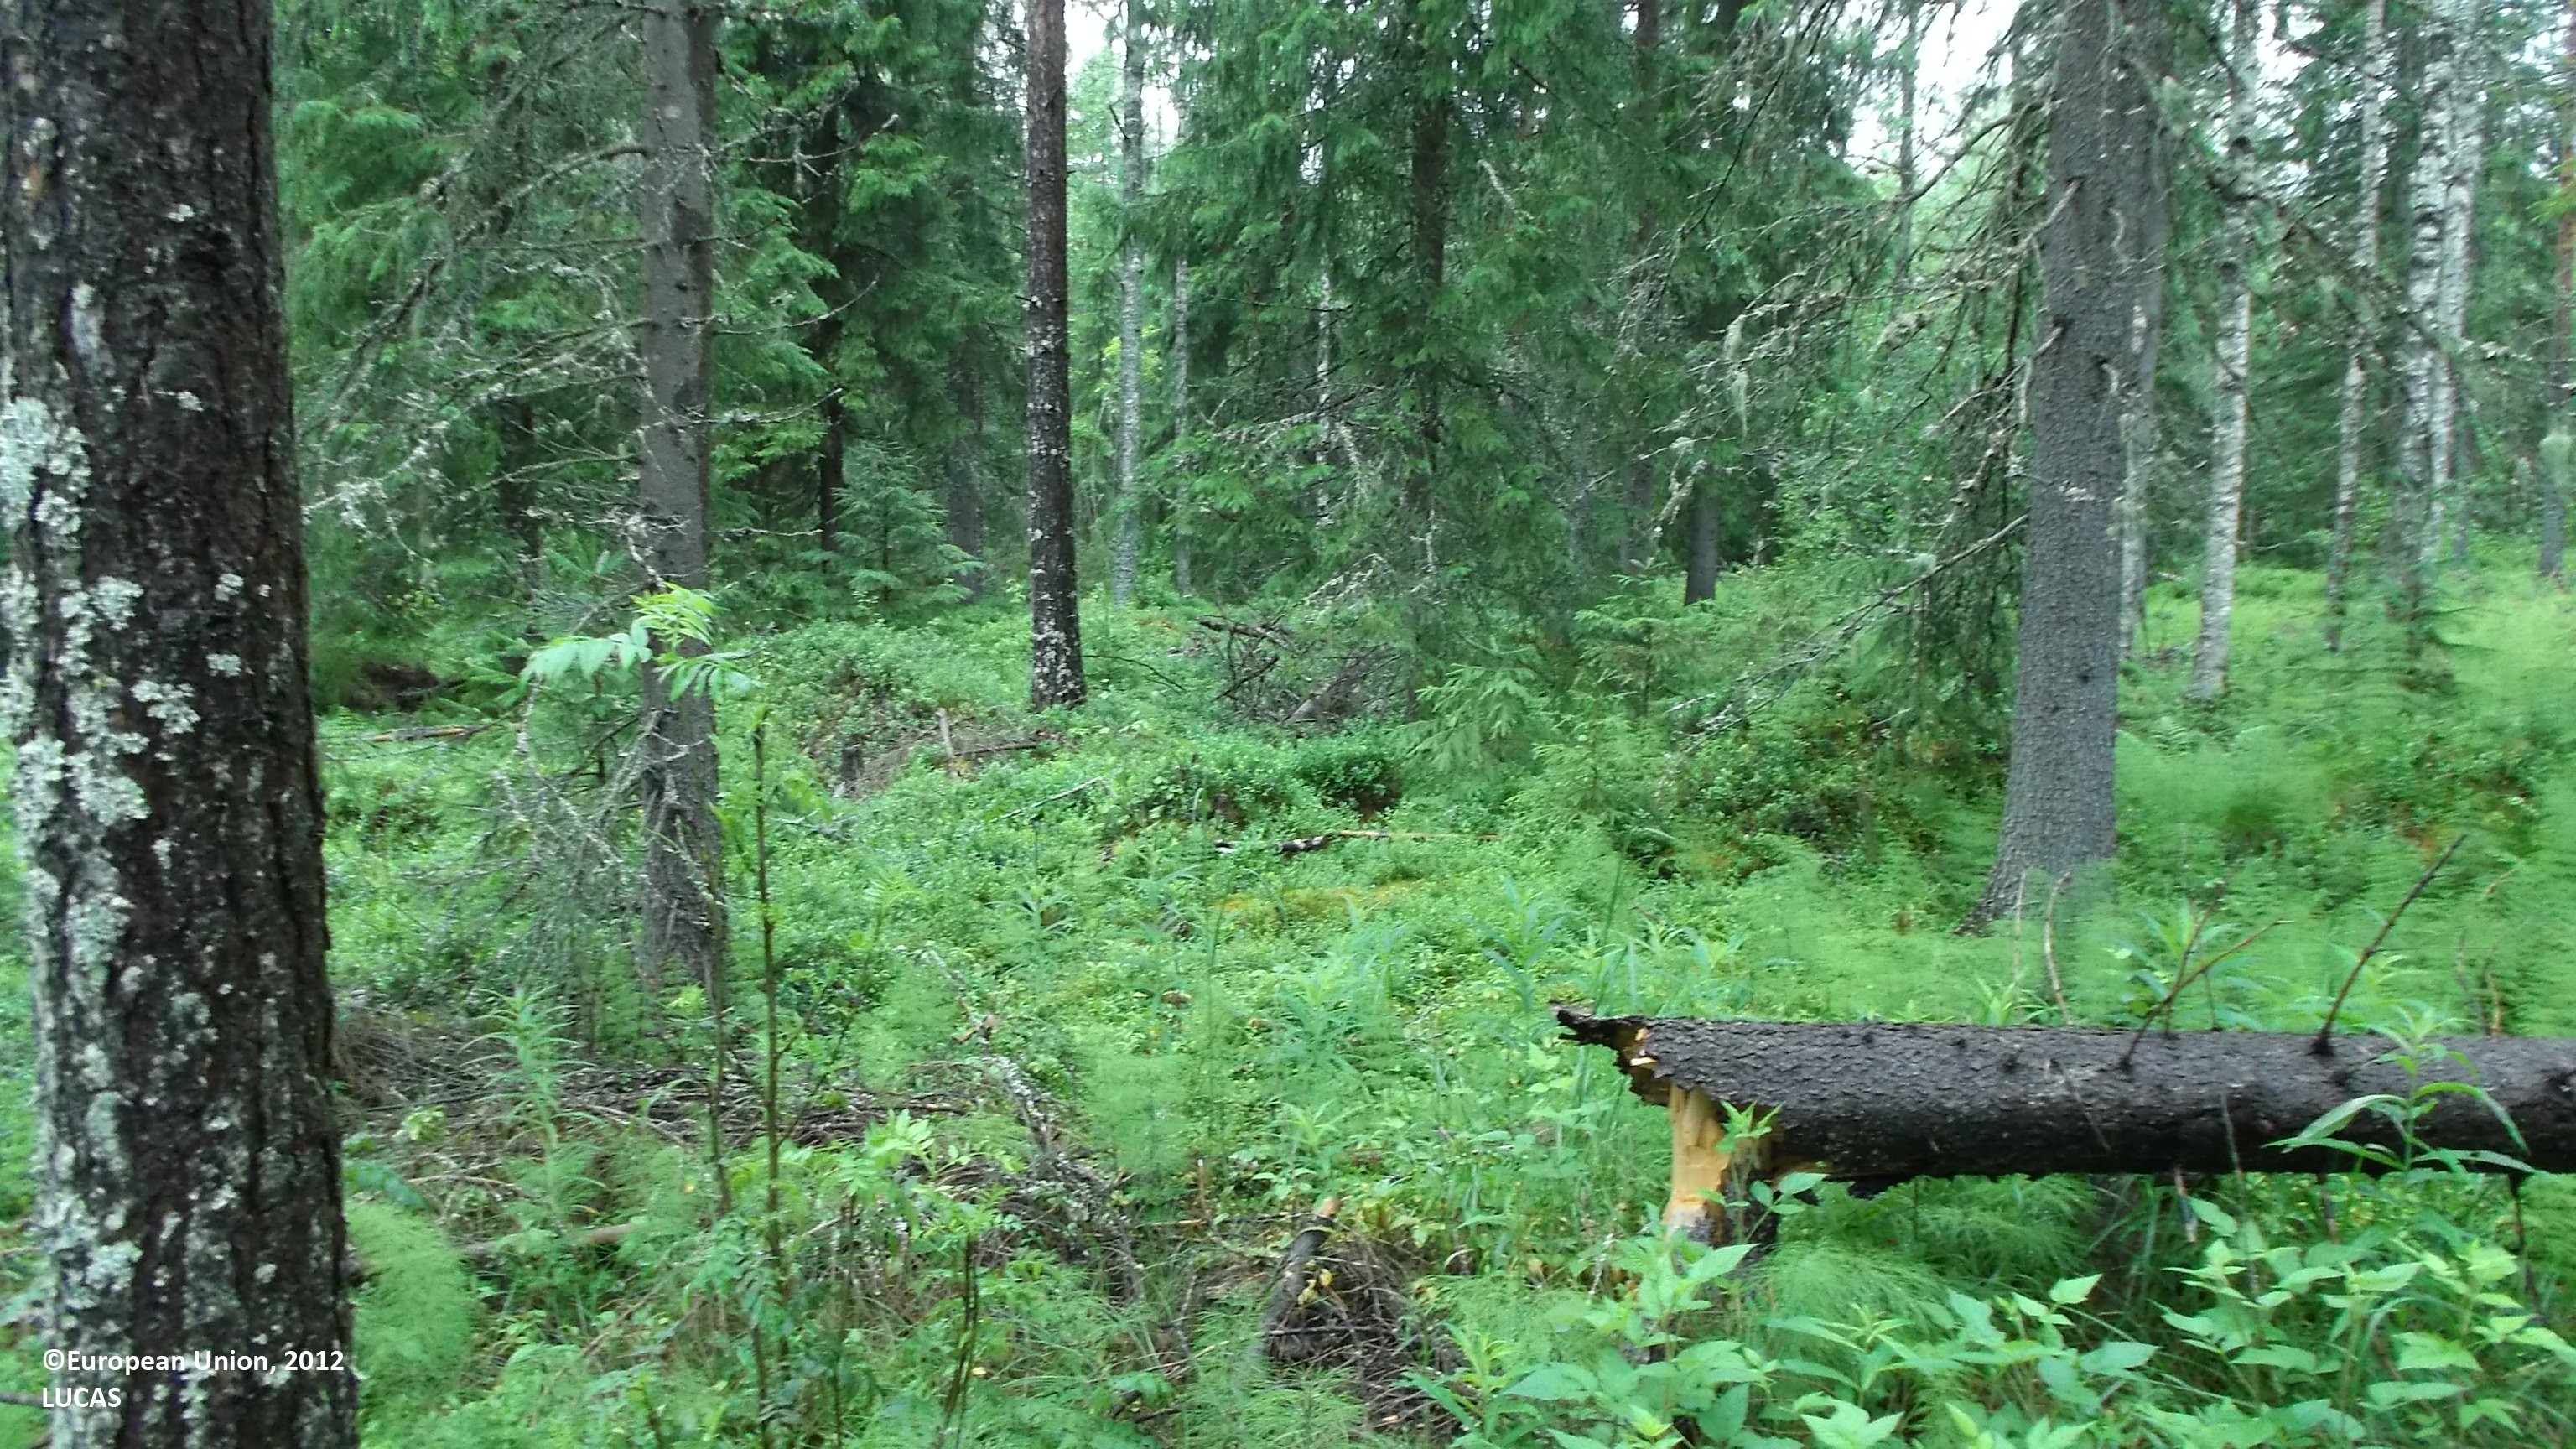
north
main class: Woodland
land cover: Other mixed woodland
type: boreal forest
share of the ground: 50 - 75 %
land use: Forestry
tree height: > 5 m
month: July
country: FI
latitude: 63.4316
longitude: 23.9173
